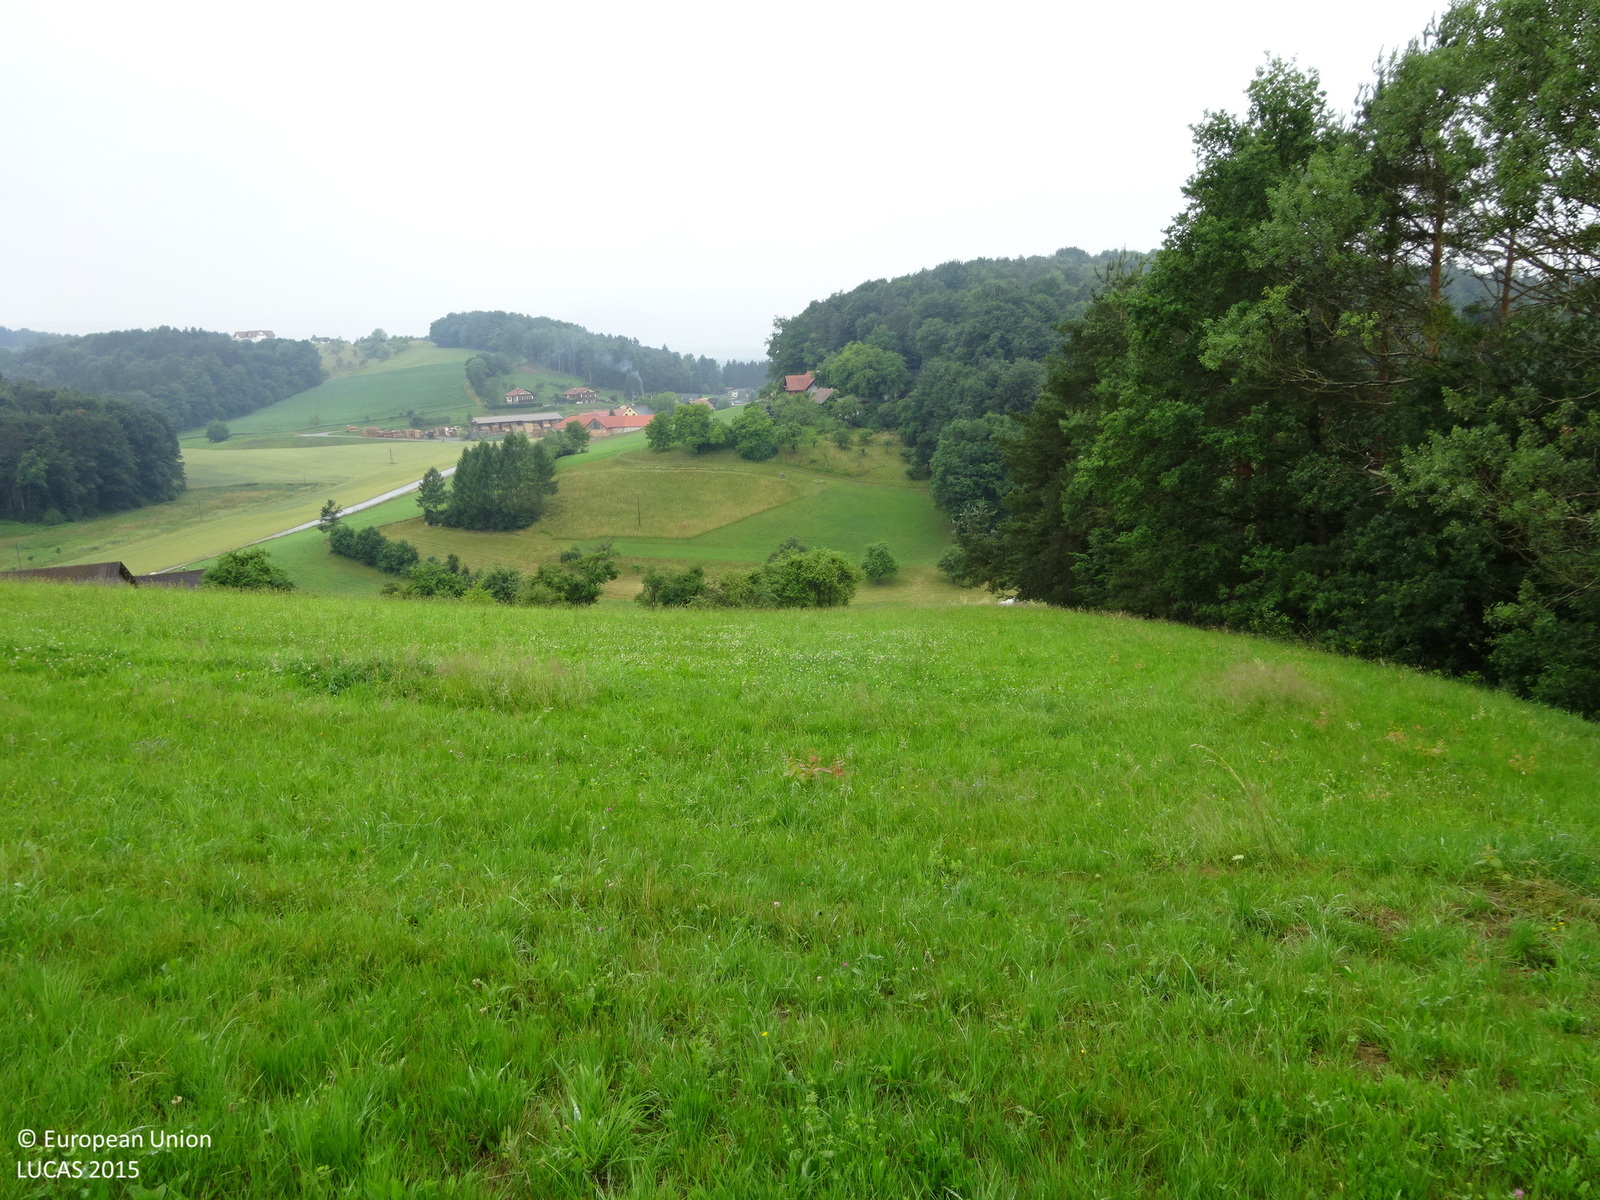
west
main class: Grassland
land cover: Grassland without tree/shrub cover
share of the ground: > 75 %
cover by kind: herbaceous plants 100 %
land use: Agriculture (excluding fallow land and kitchen gardens)
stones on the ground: < 10 %
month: June
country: AT
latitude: 46.7393
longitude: 15.3781
